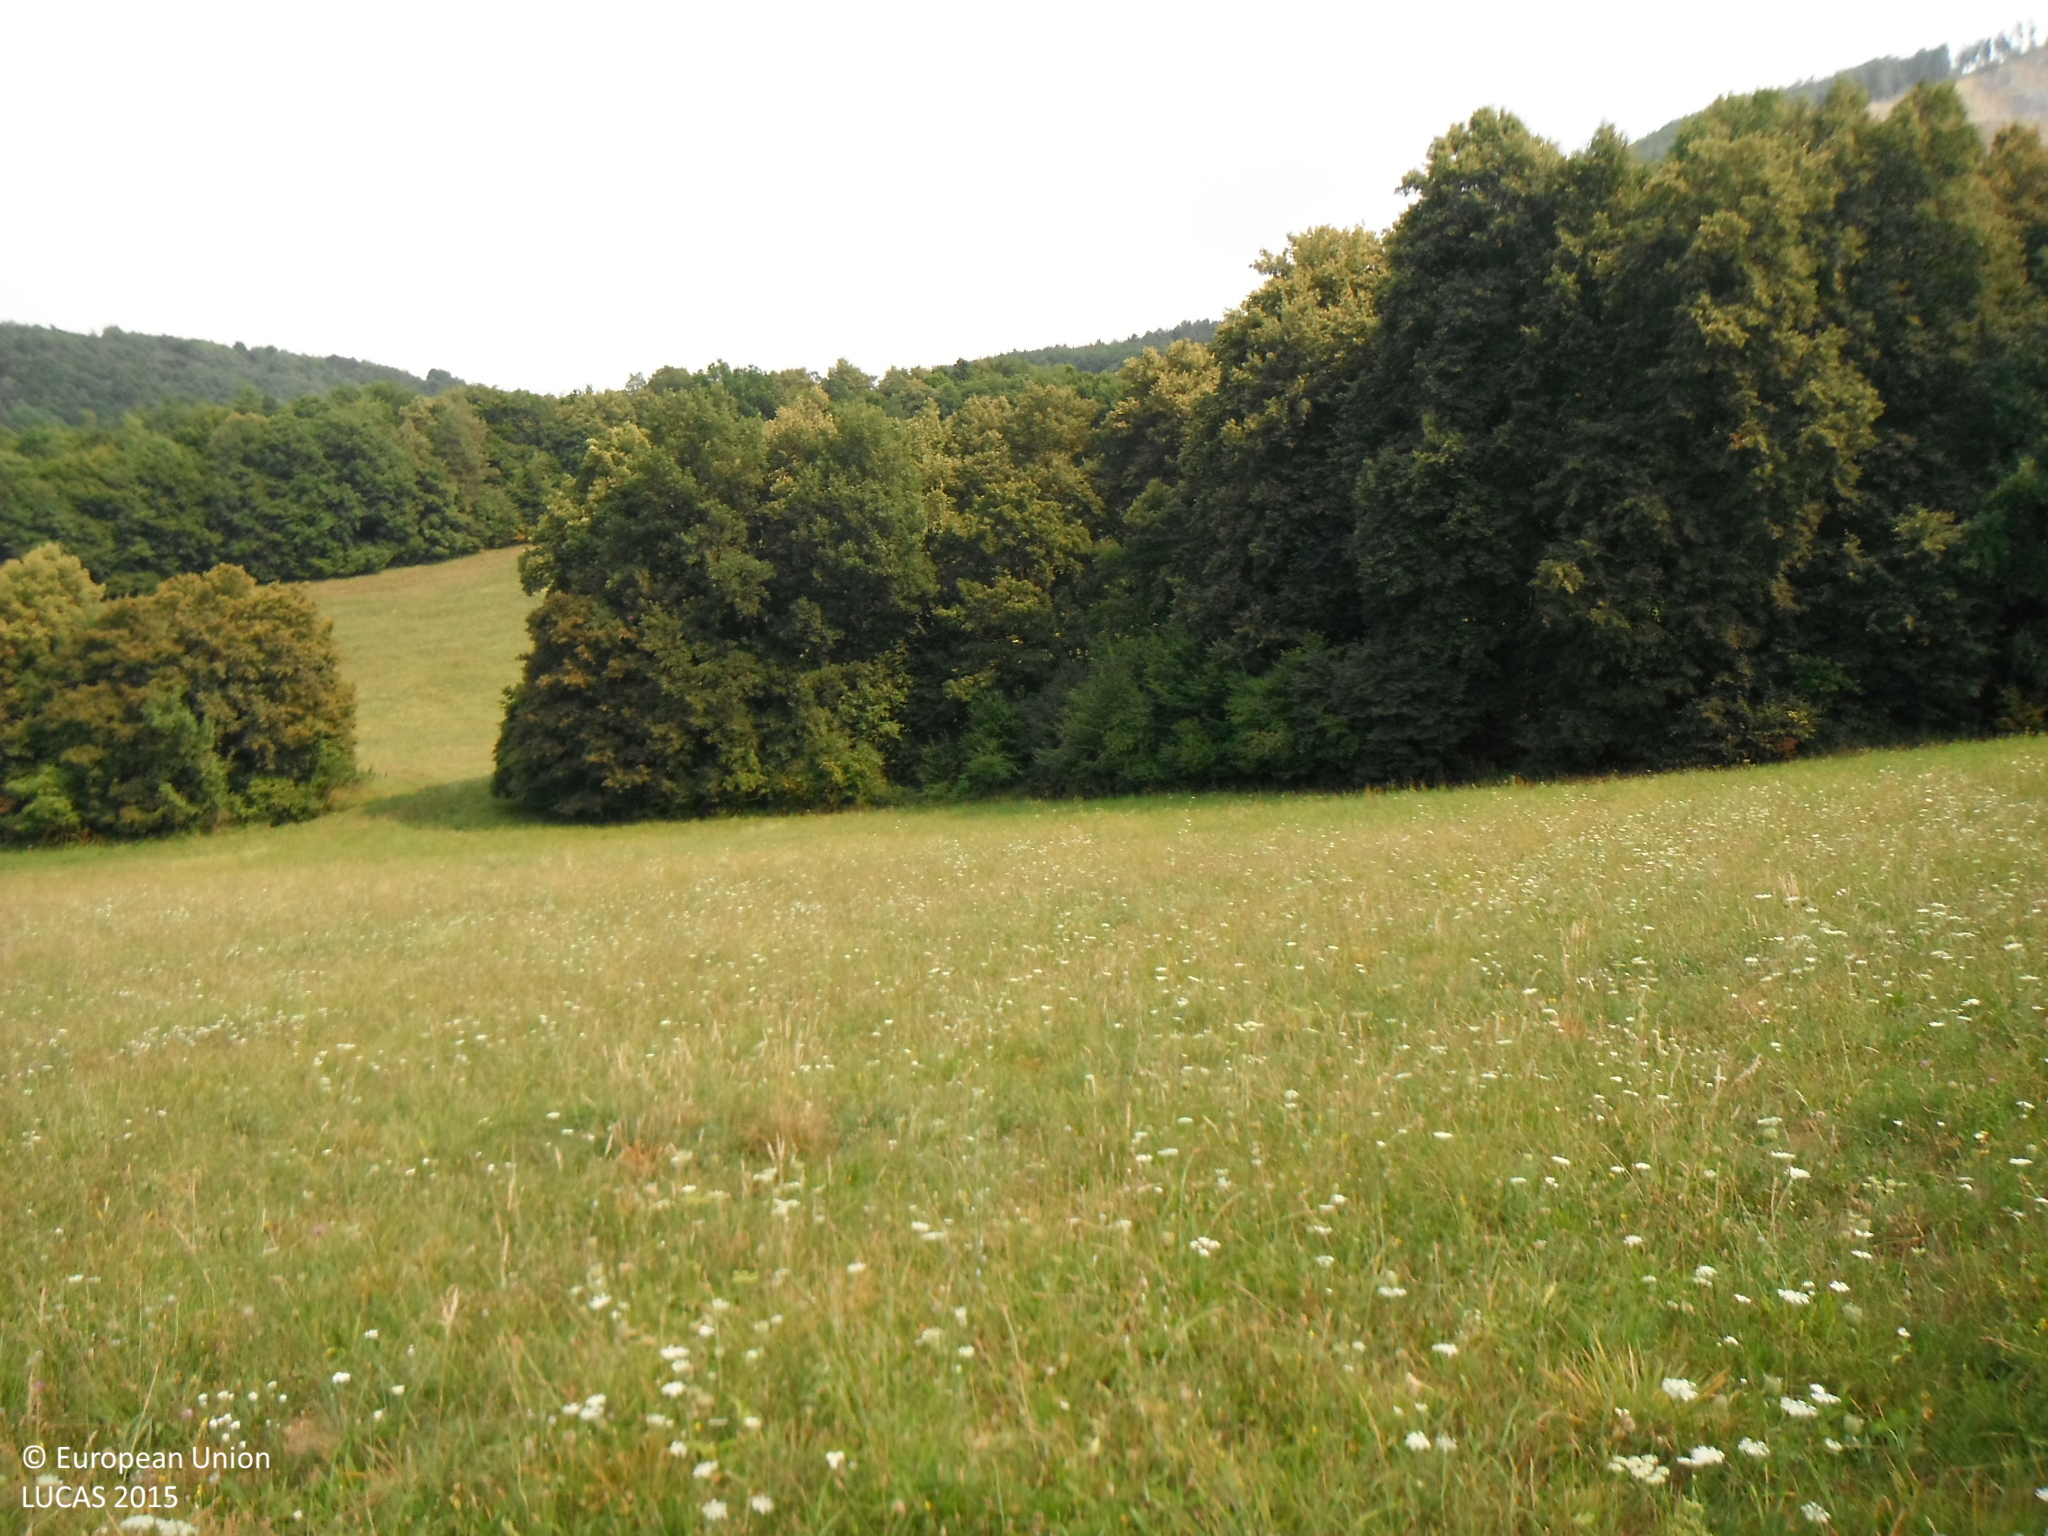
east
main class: Grassland
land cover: Grassland without tree/shrub cover
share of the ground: > 75 %
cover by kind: herbaceous plants 100 %
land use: Agriculture (excluding fallow land and kitchen gardens)
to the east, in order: Grassland without tree/shrub cover; Broadleaved woodland; Grassland without tree/shrub cover; Broadleaved woodland
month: August
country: SK
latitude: 49.0301
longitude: 18.3185
